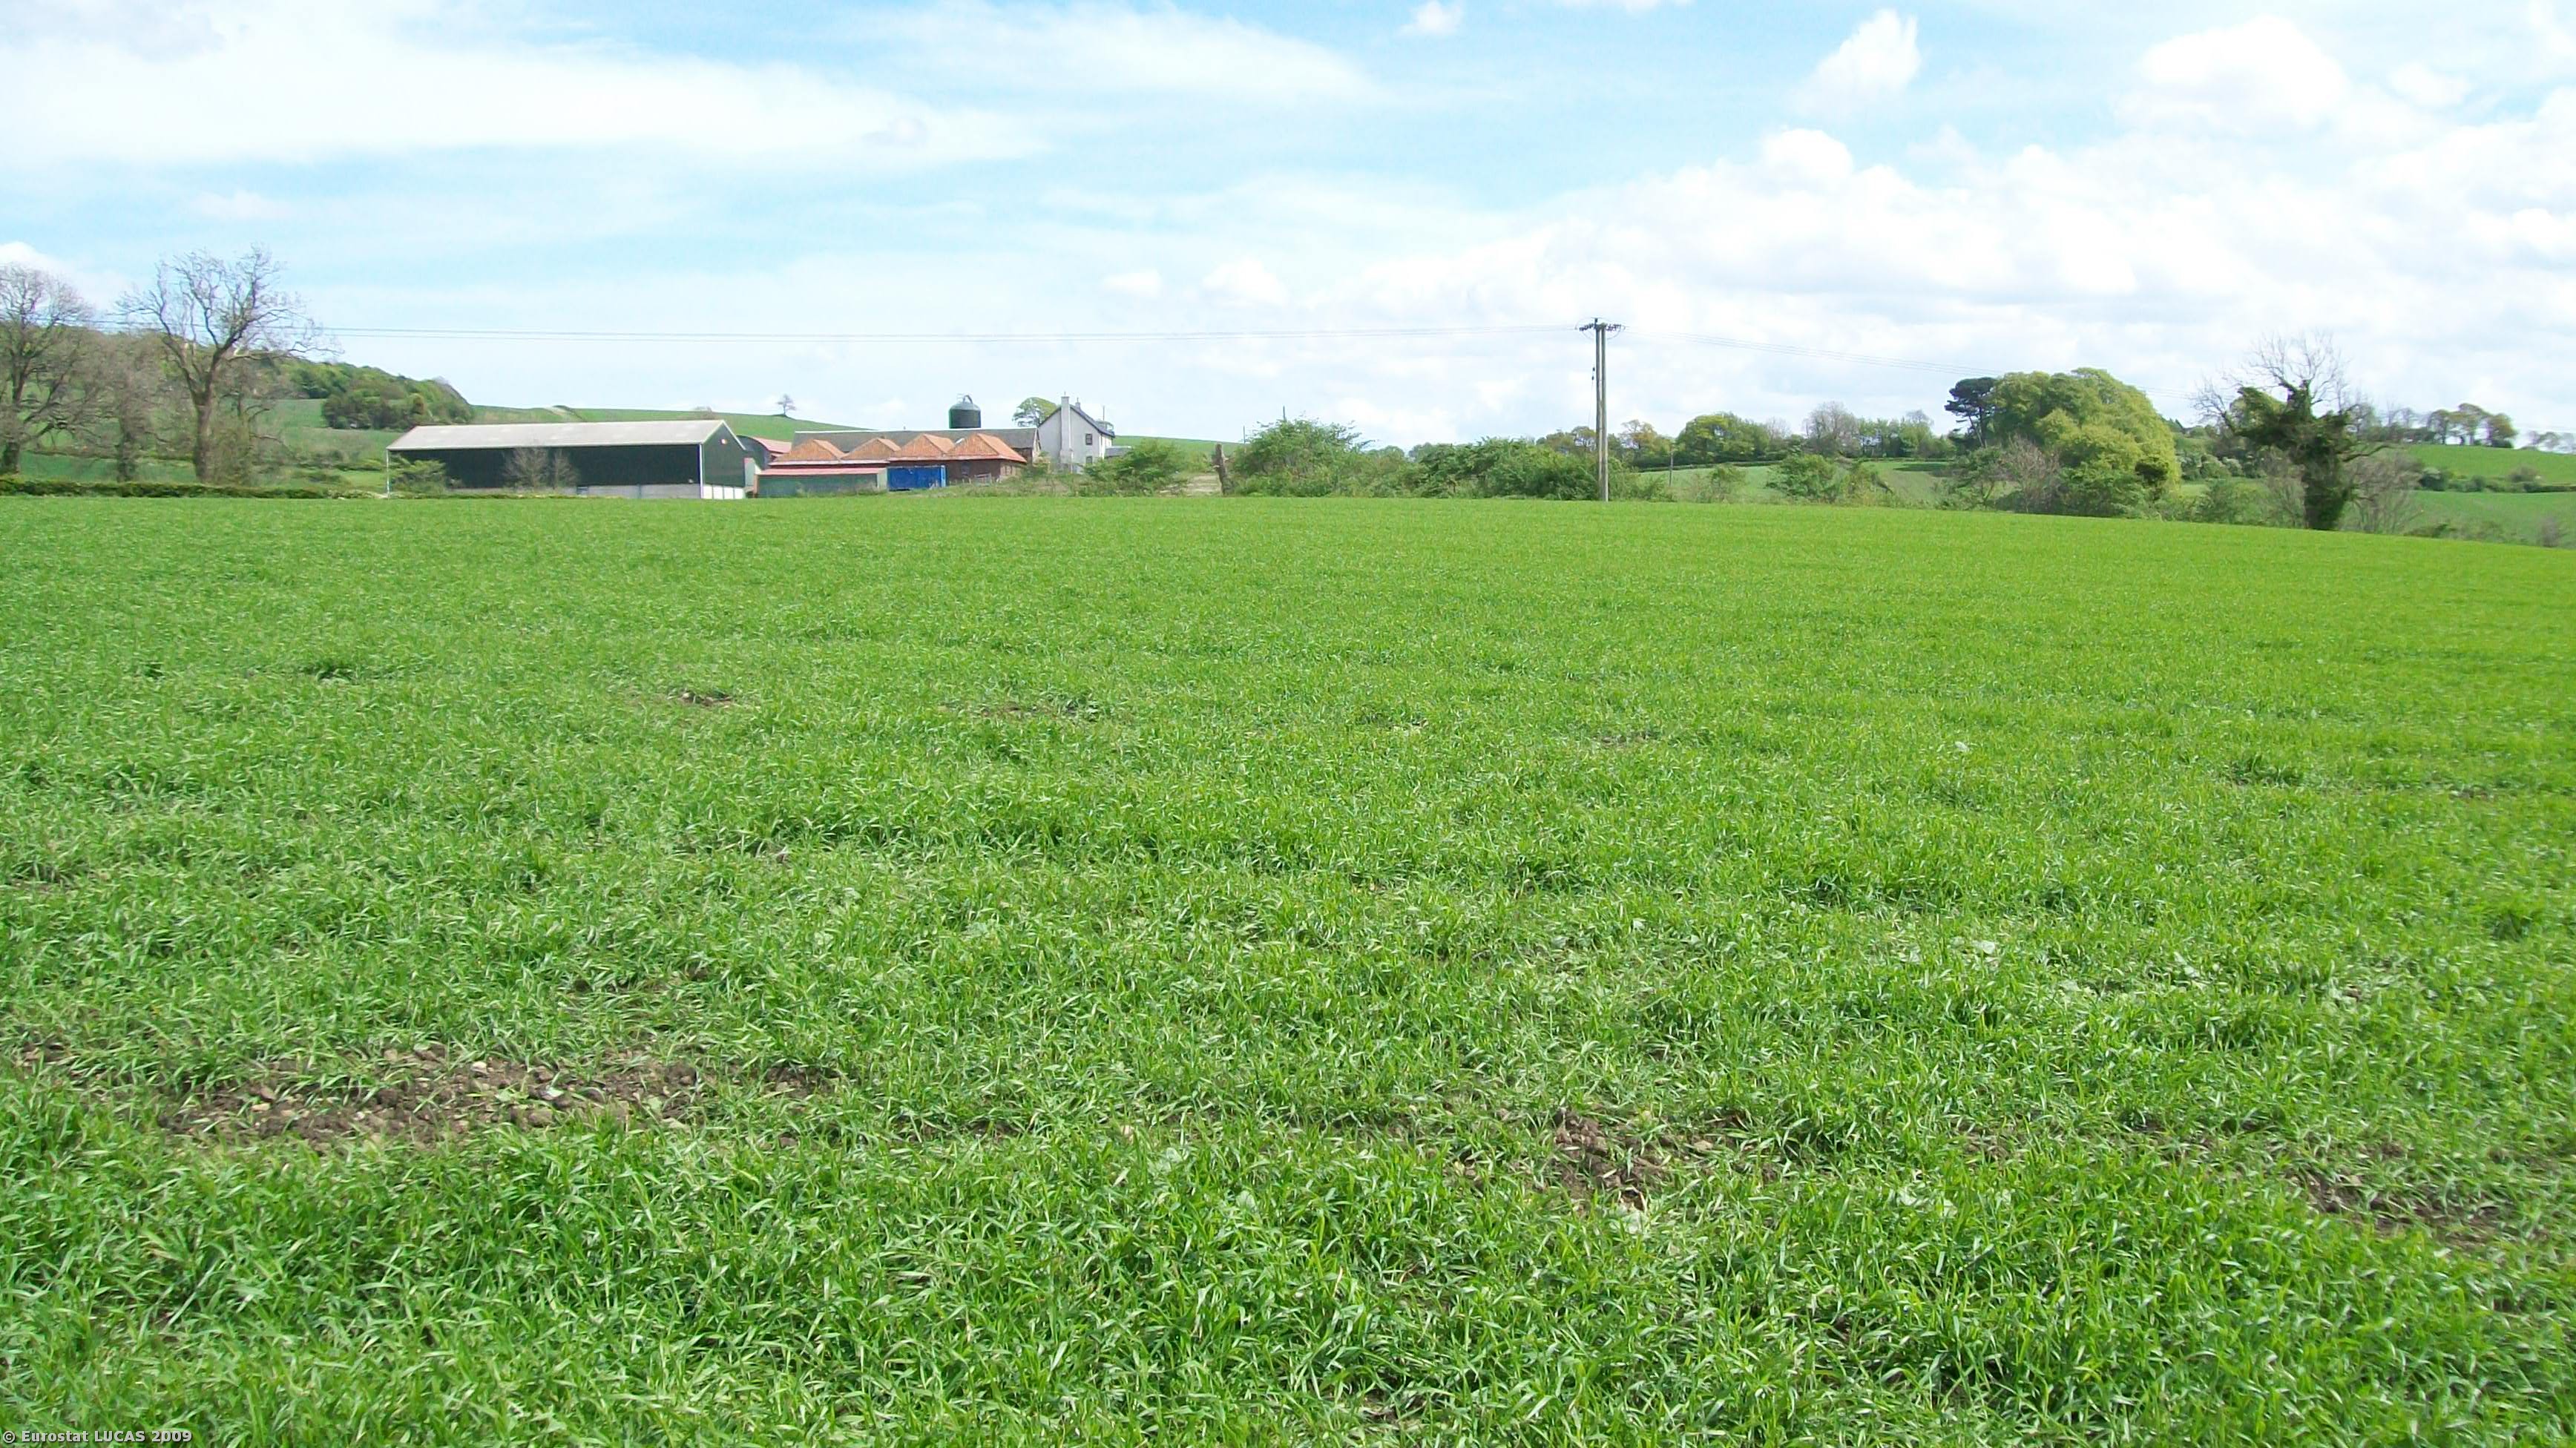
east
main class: Cropland
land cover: Barley
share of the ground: > 75 %
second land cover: Rape and turnip rape
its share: 50 - 75 %
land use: Agriculture (excluding fallow land and kitchen gardens)
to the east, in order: Barley; Grass margins; Fences; Managed hedges; Ditches and canals; Grass margins; Tracks; Grassland without tree/shrub cover; Broadleaved woodland; Fences; Grassland without tree/shrub cover
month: May
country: GB
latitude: 55.9862
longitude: -3.6242
